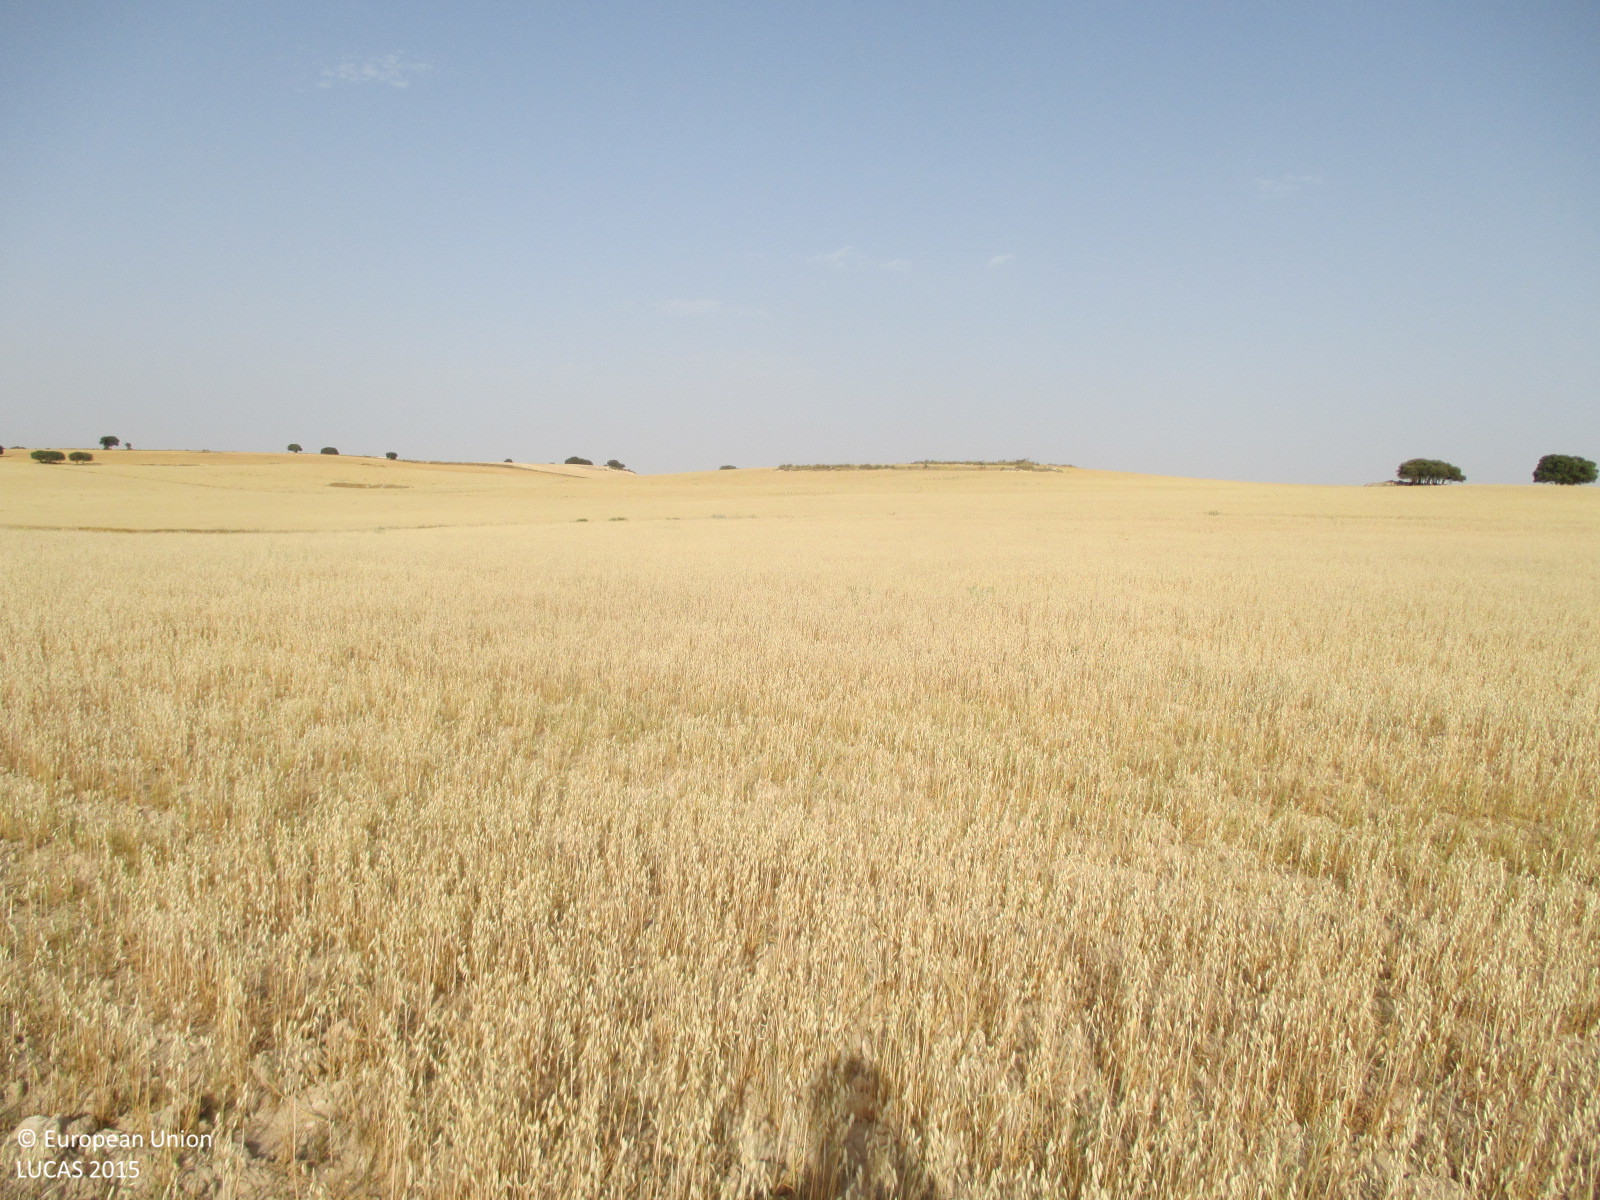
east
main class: Cropland
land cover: Oats
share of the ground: 25 - 50 %
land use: Agriculture (excluding fallow land and kitchen gardens)
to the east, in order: Oats; Grass margins; Oats; Grass margins; Oats
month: July
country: ES
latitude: 37.8353
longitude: -2.3628
